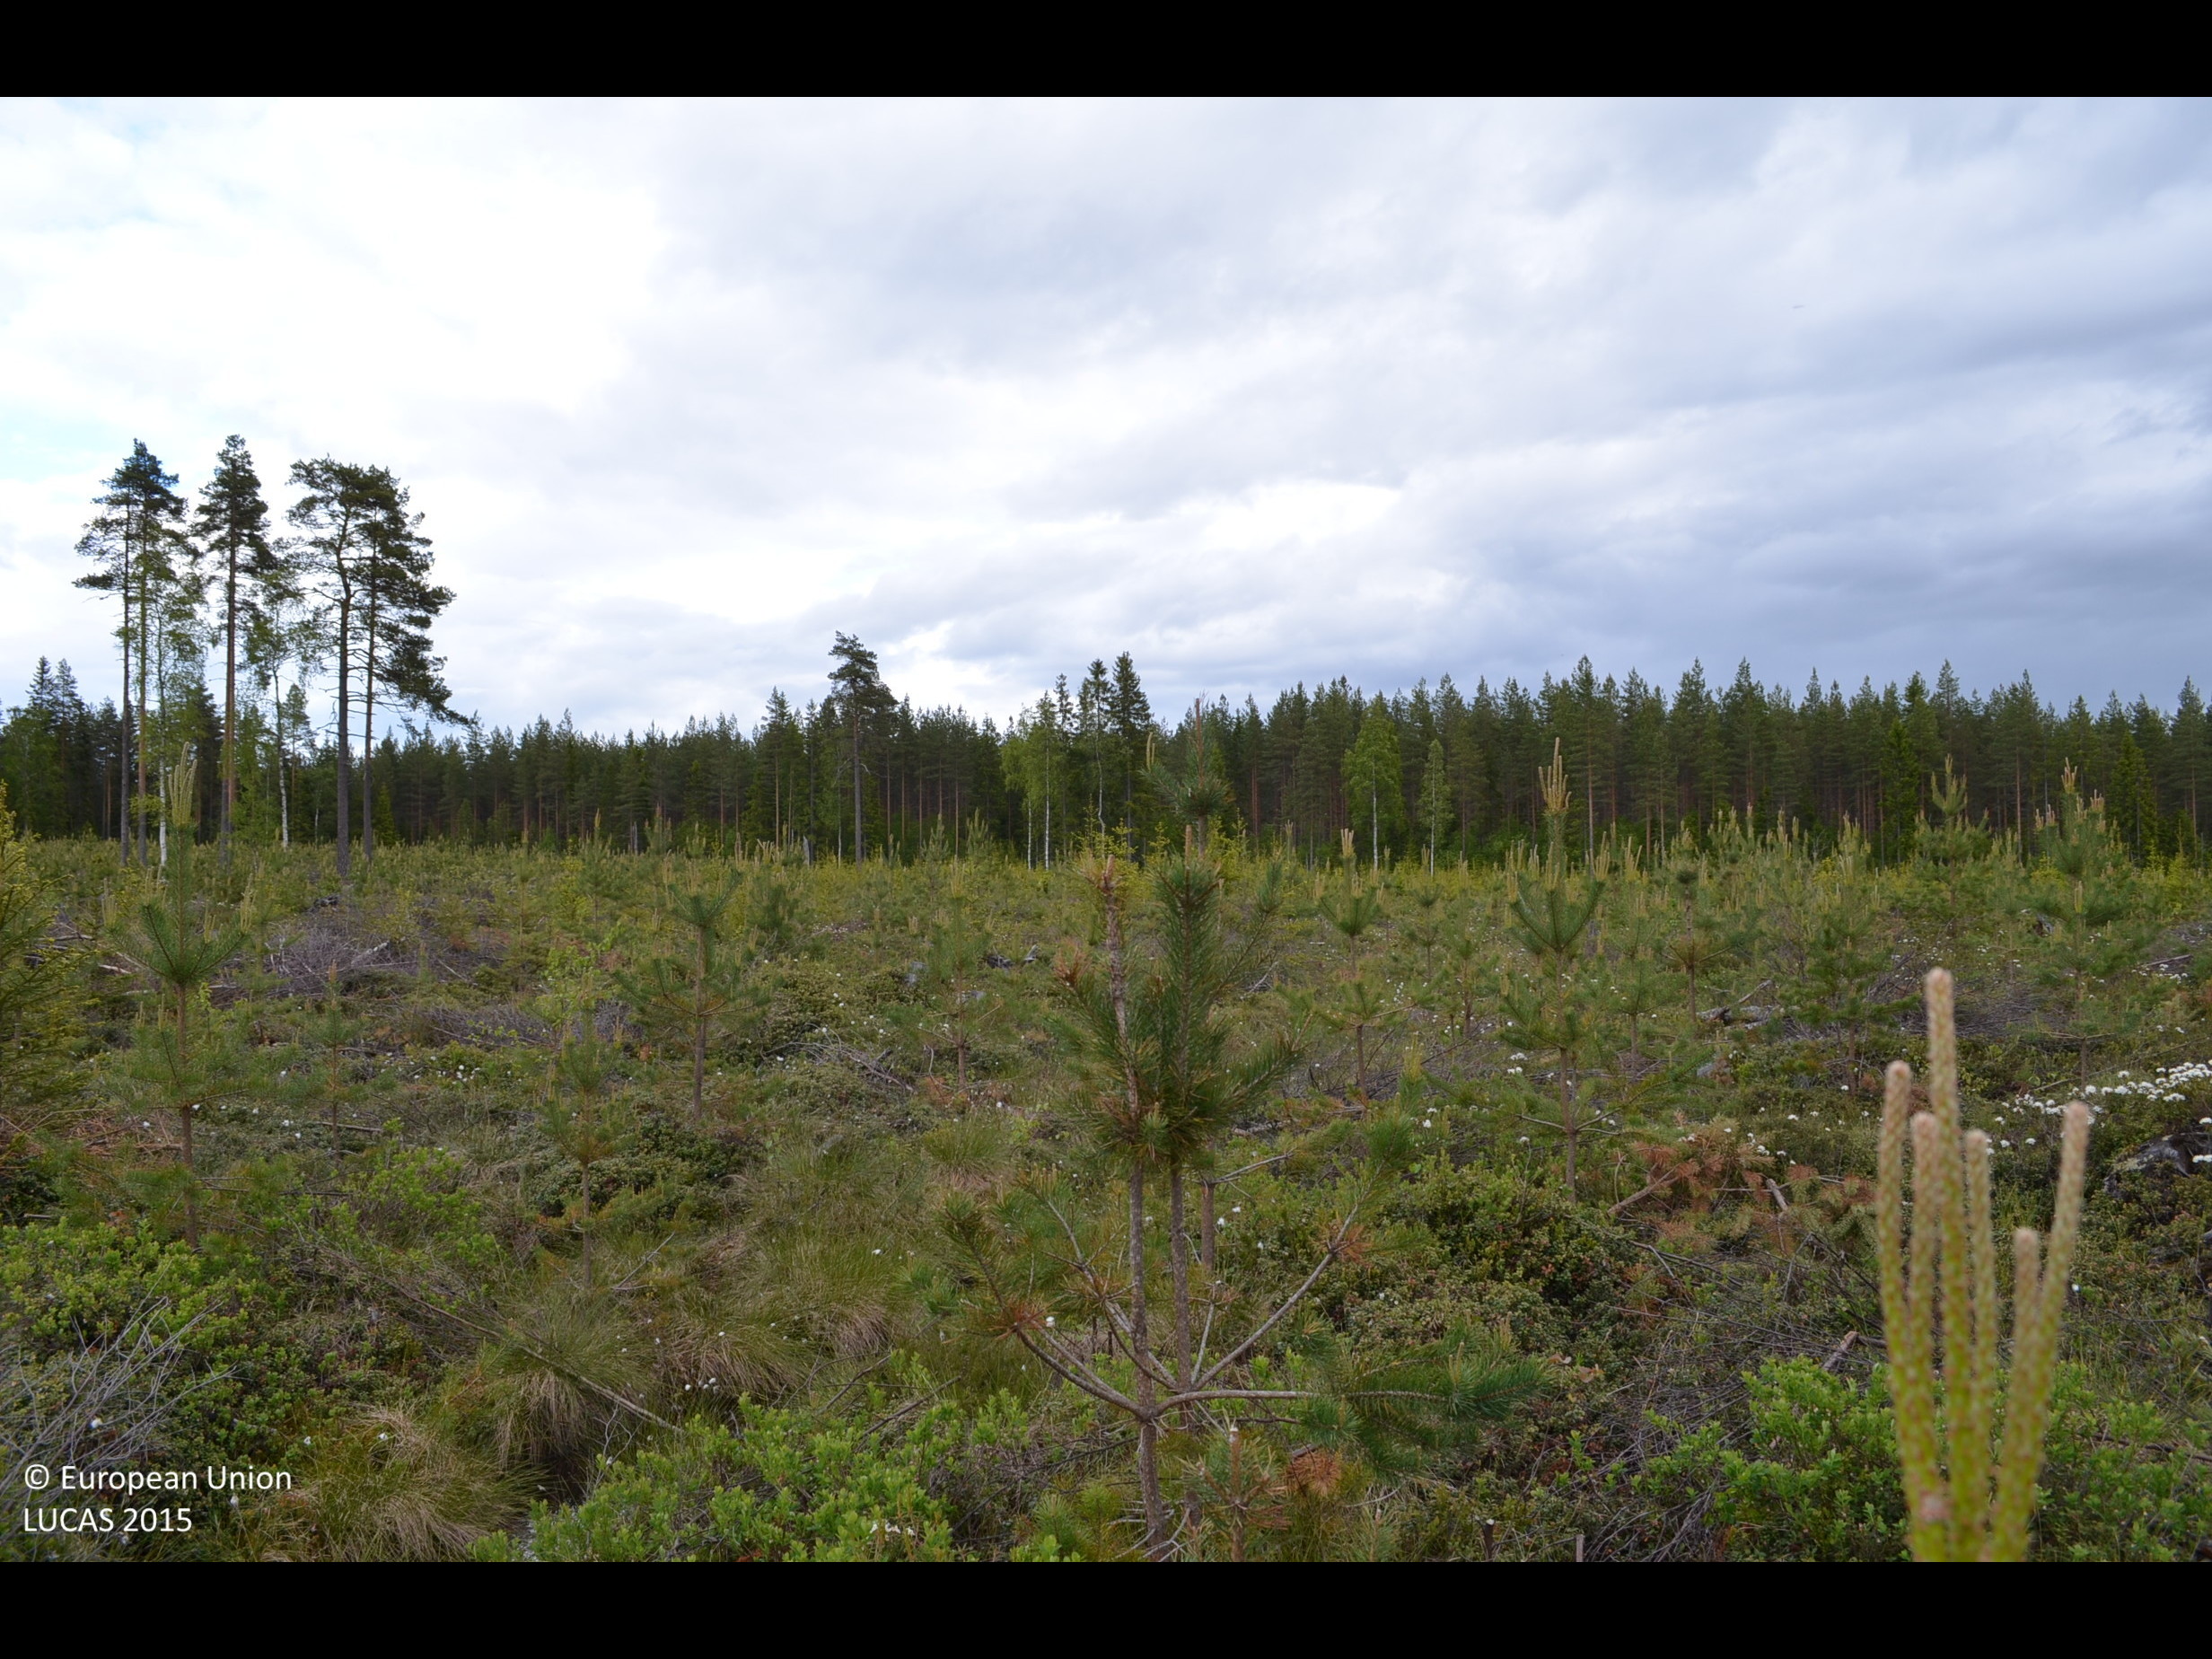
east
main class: Woodland
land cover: Other coniferous woodland
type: boreal forest
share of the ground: 25 - 50 %
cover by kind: shrubs 45 %, coniferous forest trees 35 %, lichens and mosses 10 %, herbaceous plants 5 %
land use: Forestry
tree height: < 5 m
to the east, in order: Other coniferous woodland; Ditches and canals; Other coniferous woodland; Ditches and canals; Other coniferous woodland; Ditches and canals; Pine dominated coniferous woodland; Ditches and canals; Pine dominated coniferous woodland; Ditches and canals; Pine dominated coniferous woodland; Ditches and canals; Pine dominated coniferous woodland; Ditches and canals; Pine dominated coniferous woodland
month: June
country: FI
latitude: 61.9019
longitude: 23.3779
